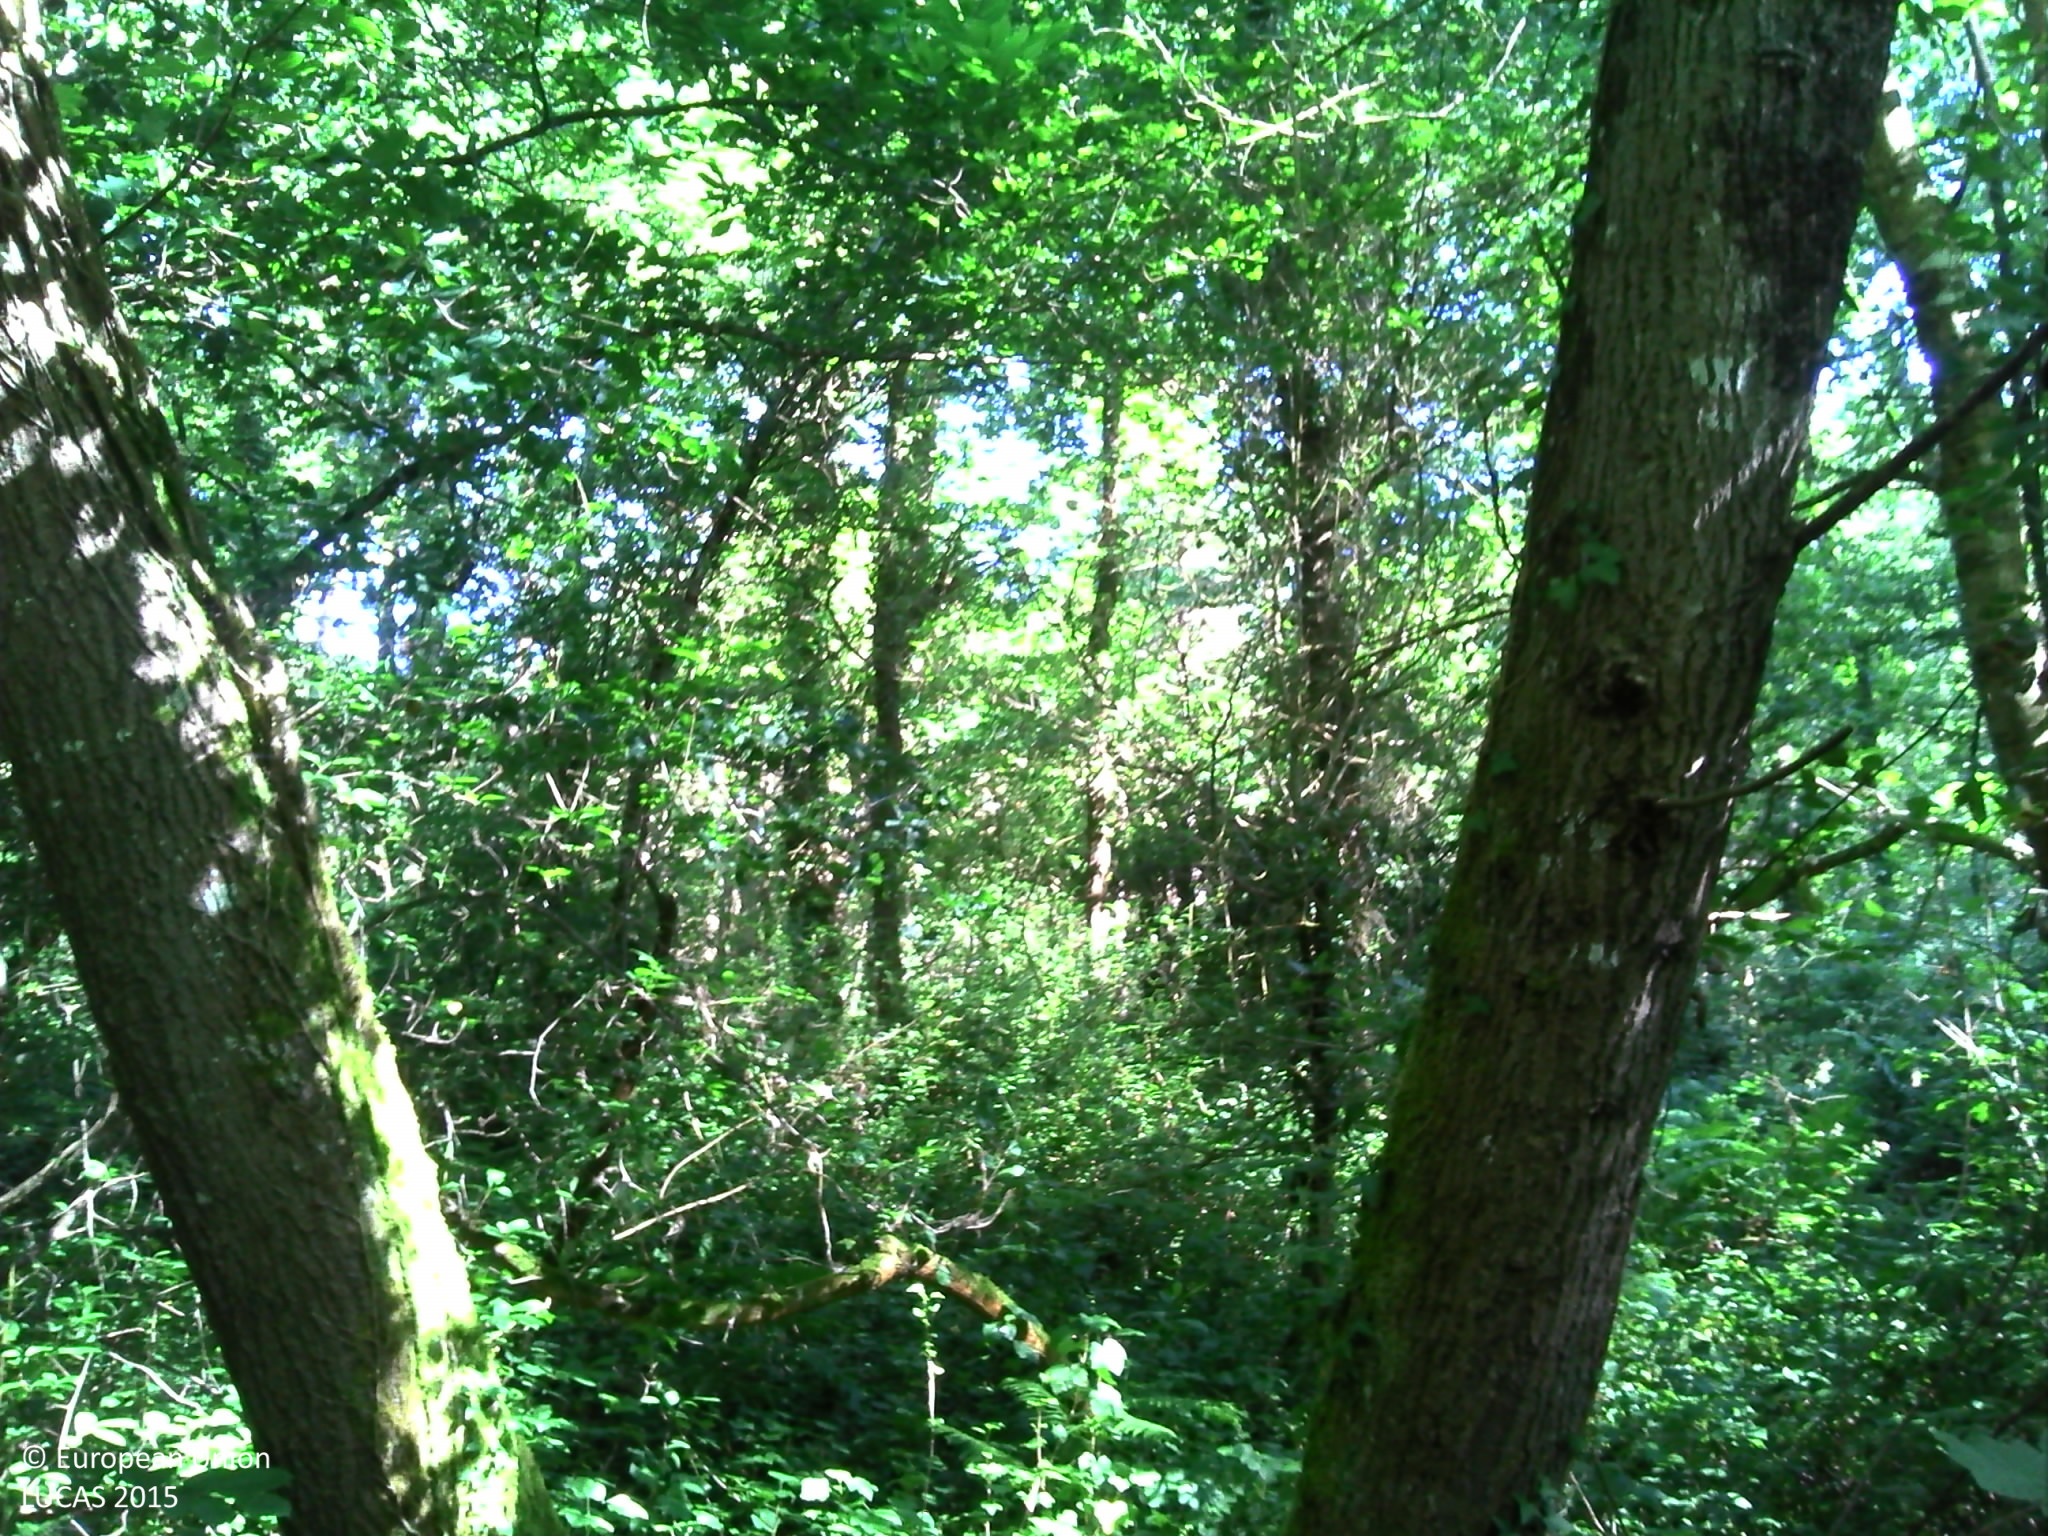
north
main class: Woodland
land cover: Broadleaved woodland
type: acidophilous oak and oak-birch forest
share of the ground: > 75 %
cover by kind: broadleaved forest trees 75 %, herbaceous plants 15 %, shrubs 10 %
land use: Forestry
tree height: > 5 m
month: June
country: FR
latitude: 47.9146
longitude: 0.2200
